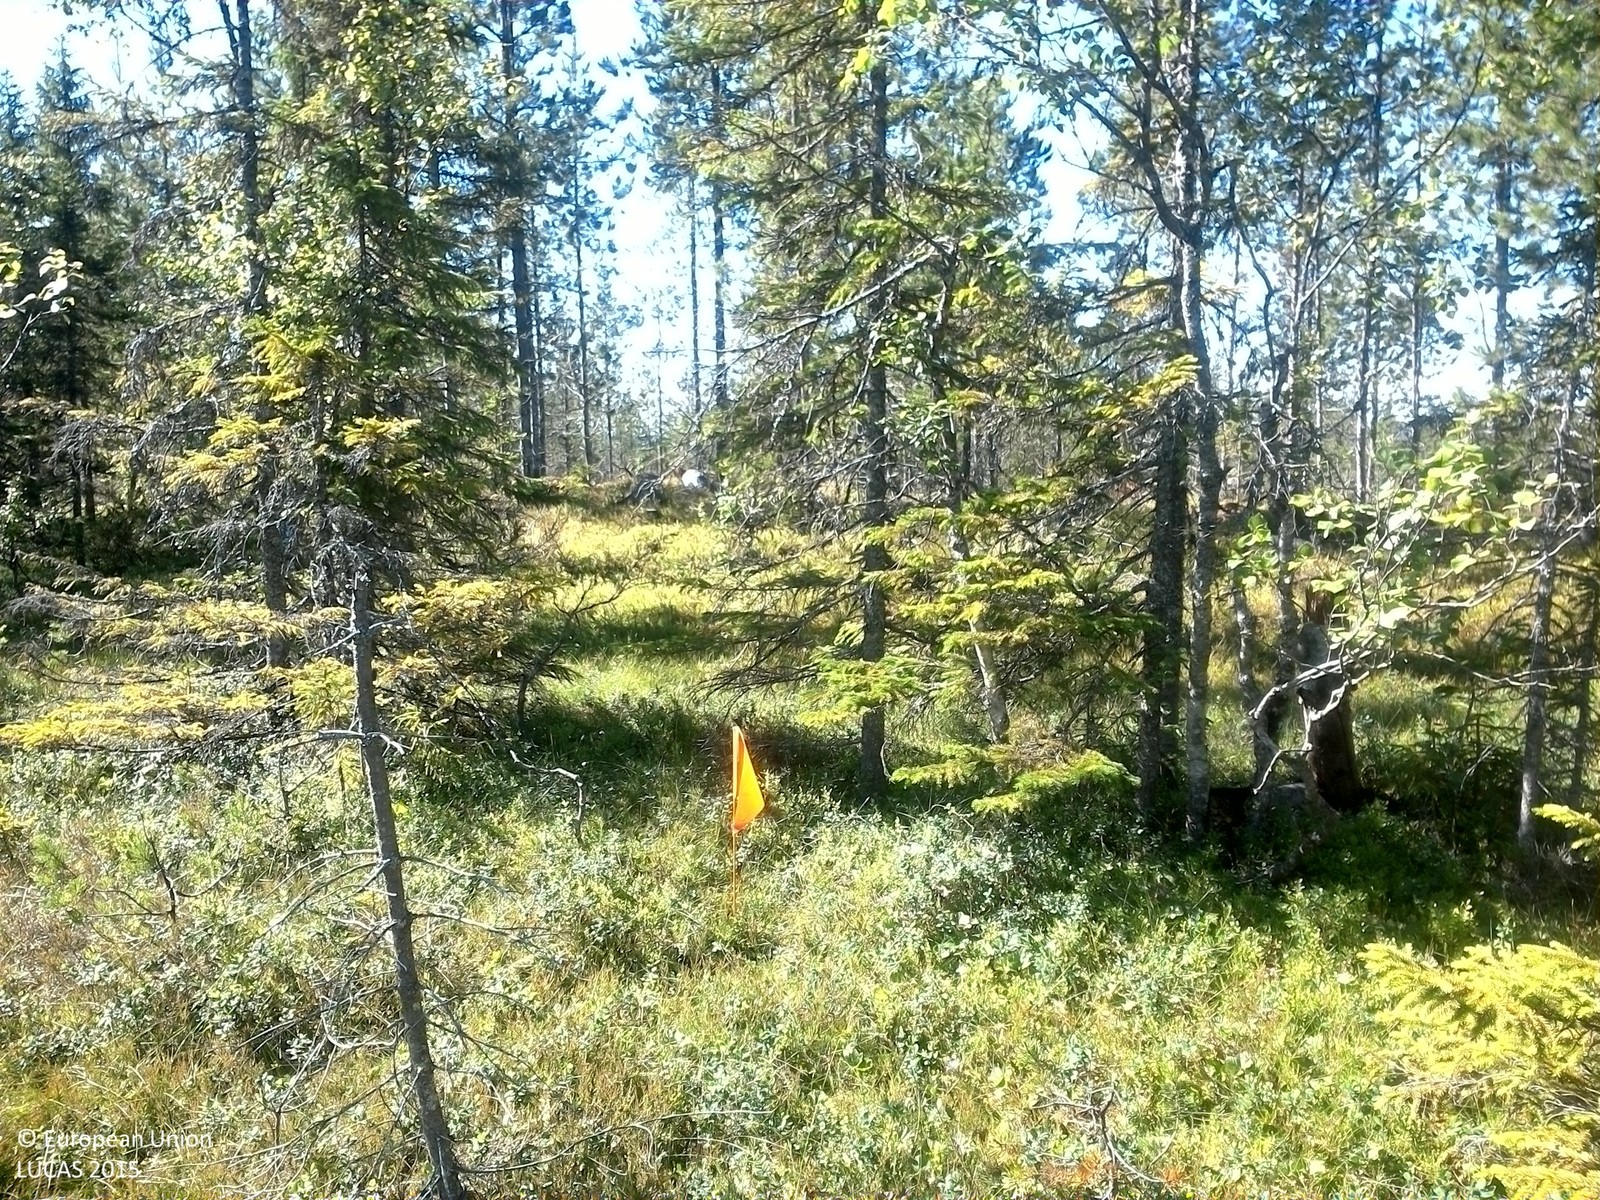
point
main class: Woodland
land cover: Spruce dominated mixed woodland
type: boreal forest
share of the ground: 25 - 50 %
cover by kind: shrubs 40 %, coniferous forest trees 20 %, lichens and mosses 20 %, broadleaved forest trees 10 %, herbaceous plants 10 %
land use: Semi-natural and natural areas not in use
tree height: > 5 m
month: August
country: SE
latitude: 62.8178
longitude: 17.2575
